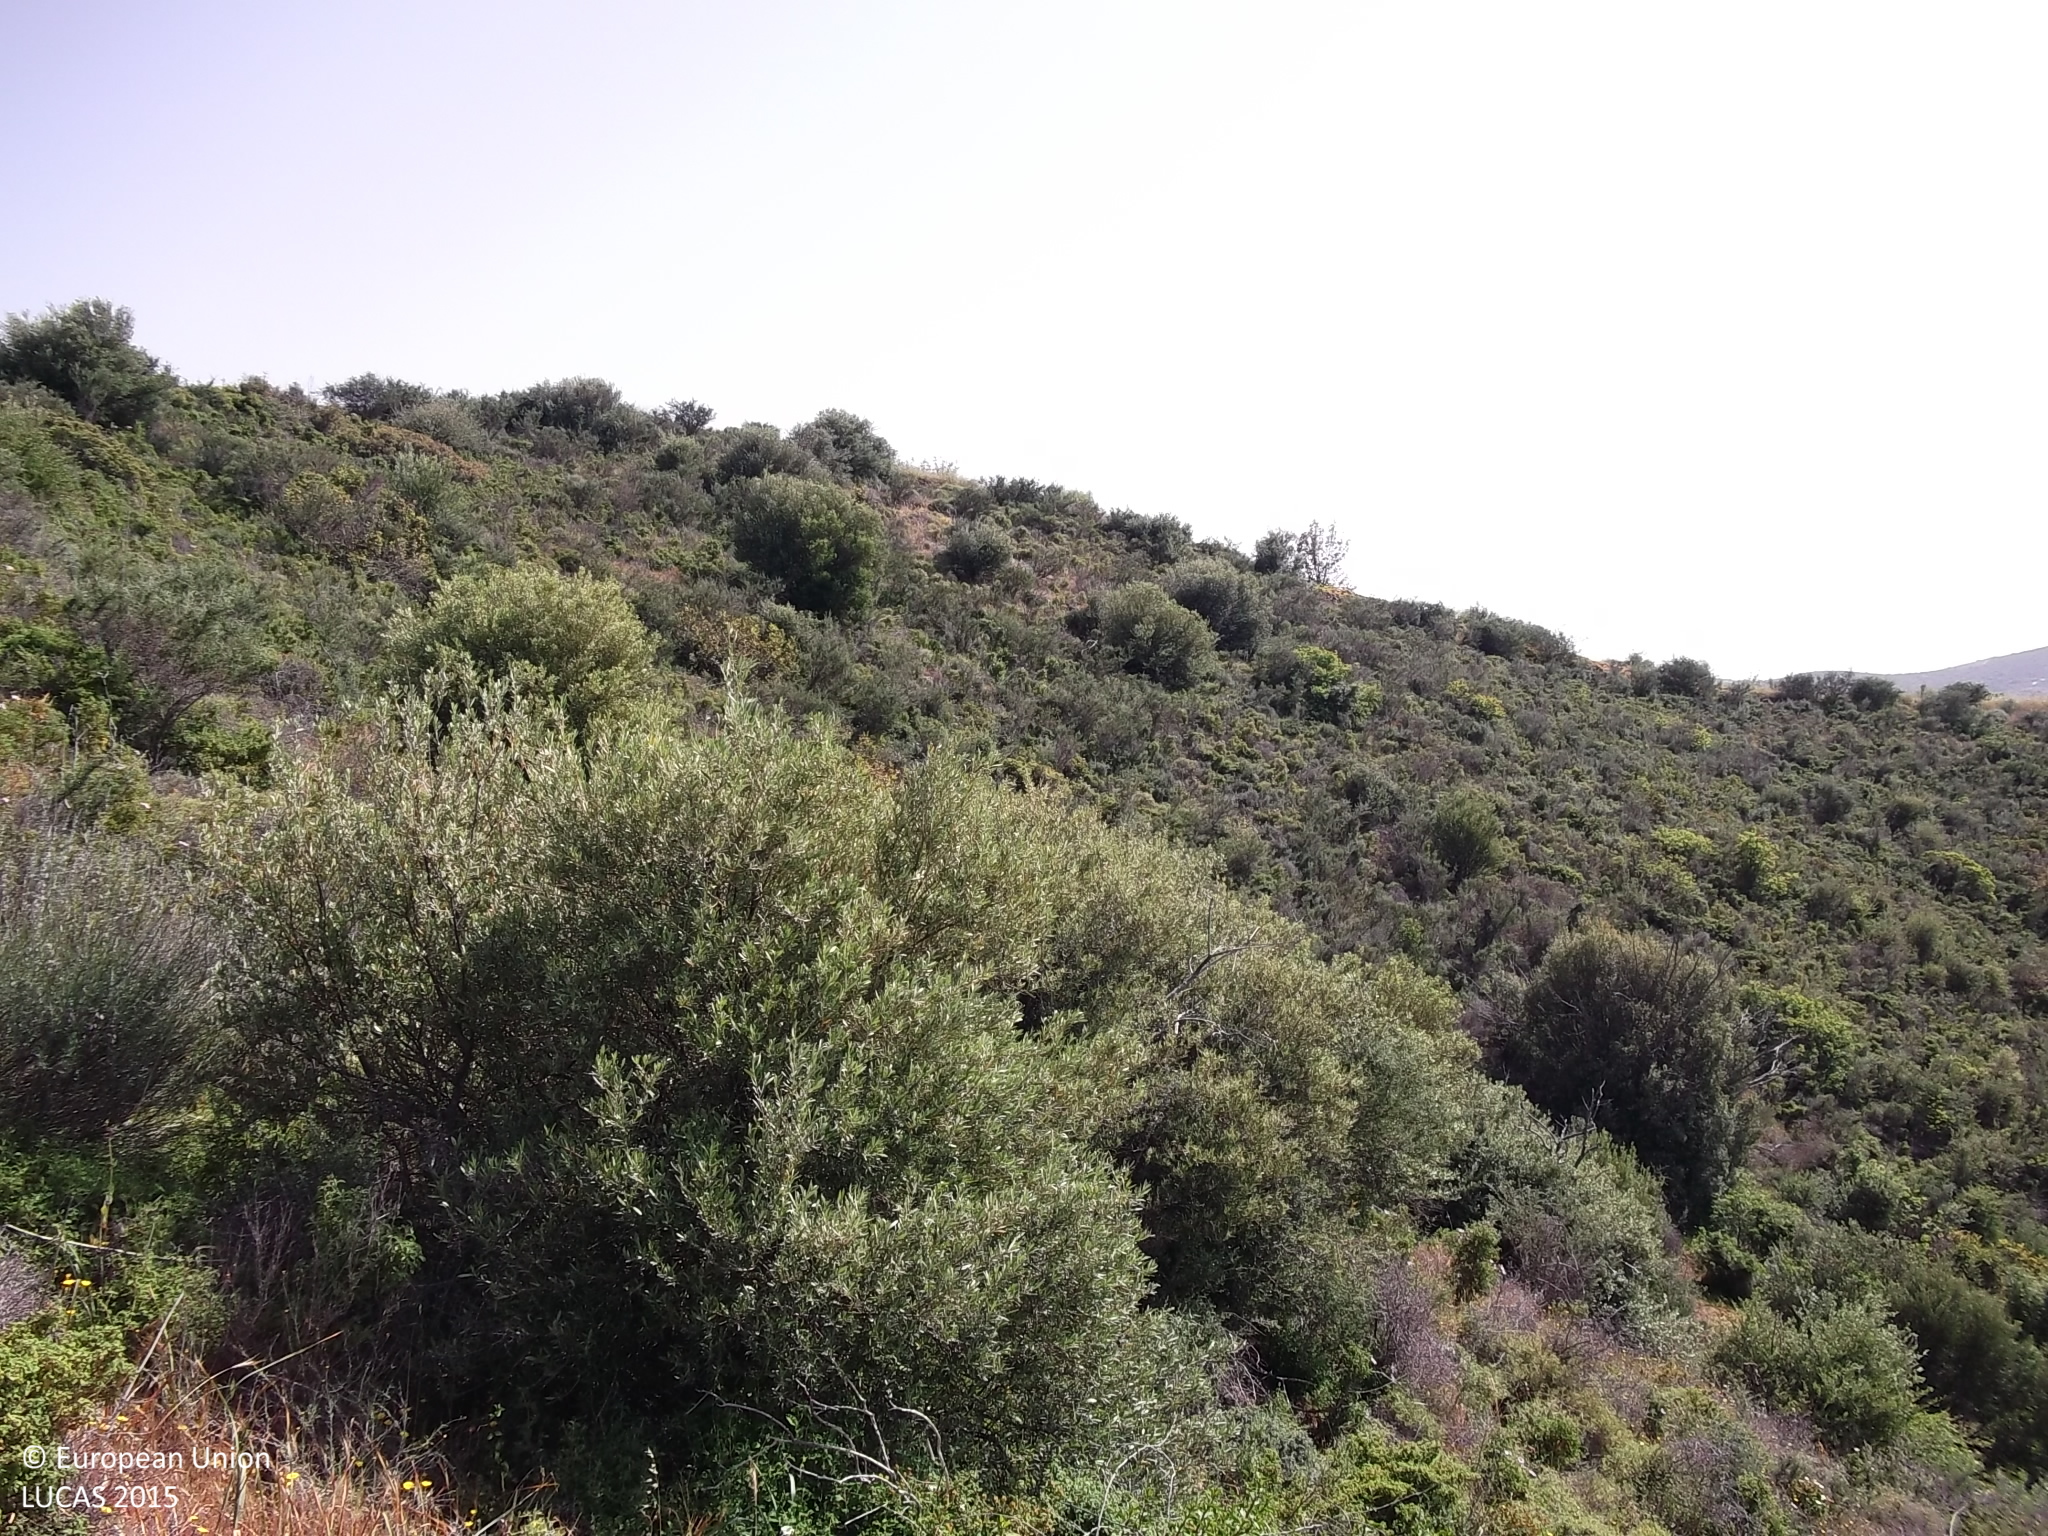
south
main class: Shrubland
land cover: Shrubland with sparse tree cover
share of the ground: > 75 %
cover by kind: shrubs 95 %, broadleaved forest trees 5 %
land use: Semi-natural and natural areas not in use
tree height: < 5 m
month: April
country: CY
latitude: 34.8744
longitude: 33.3434
